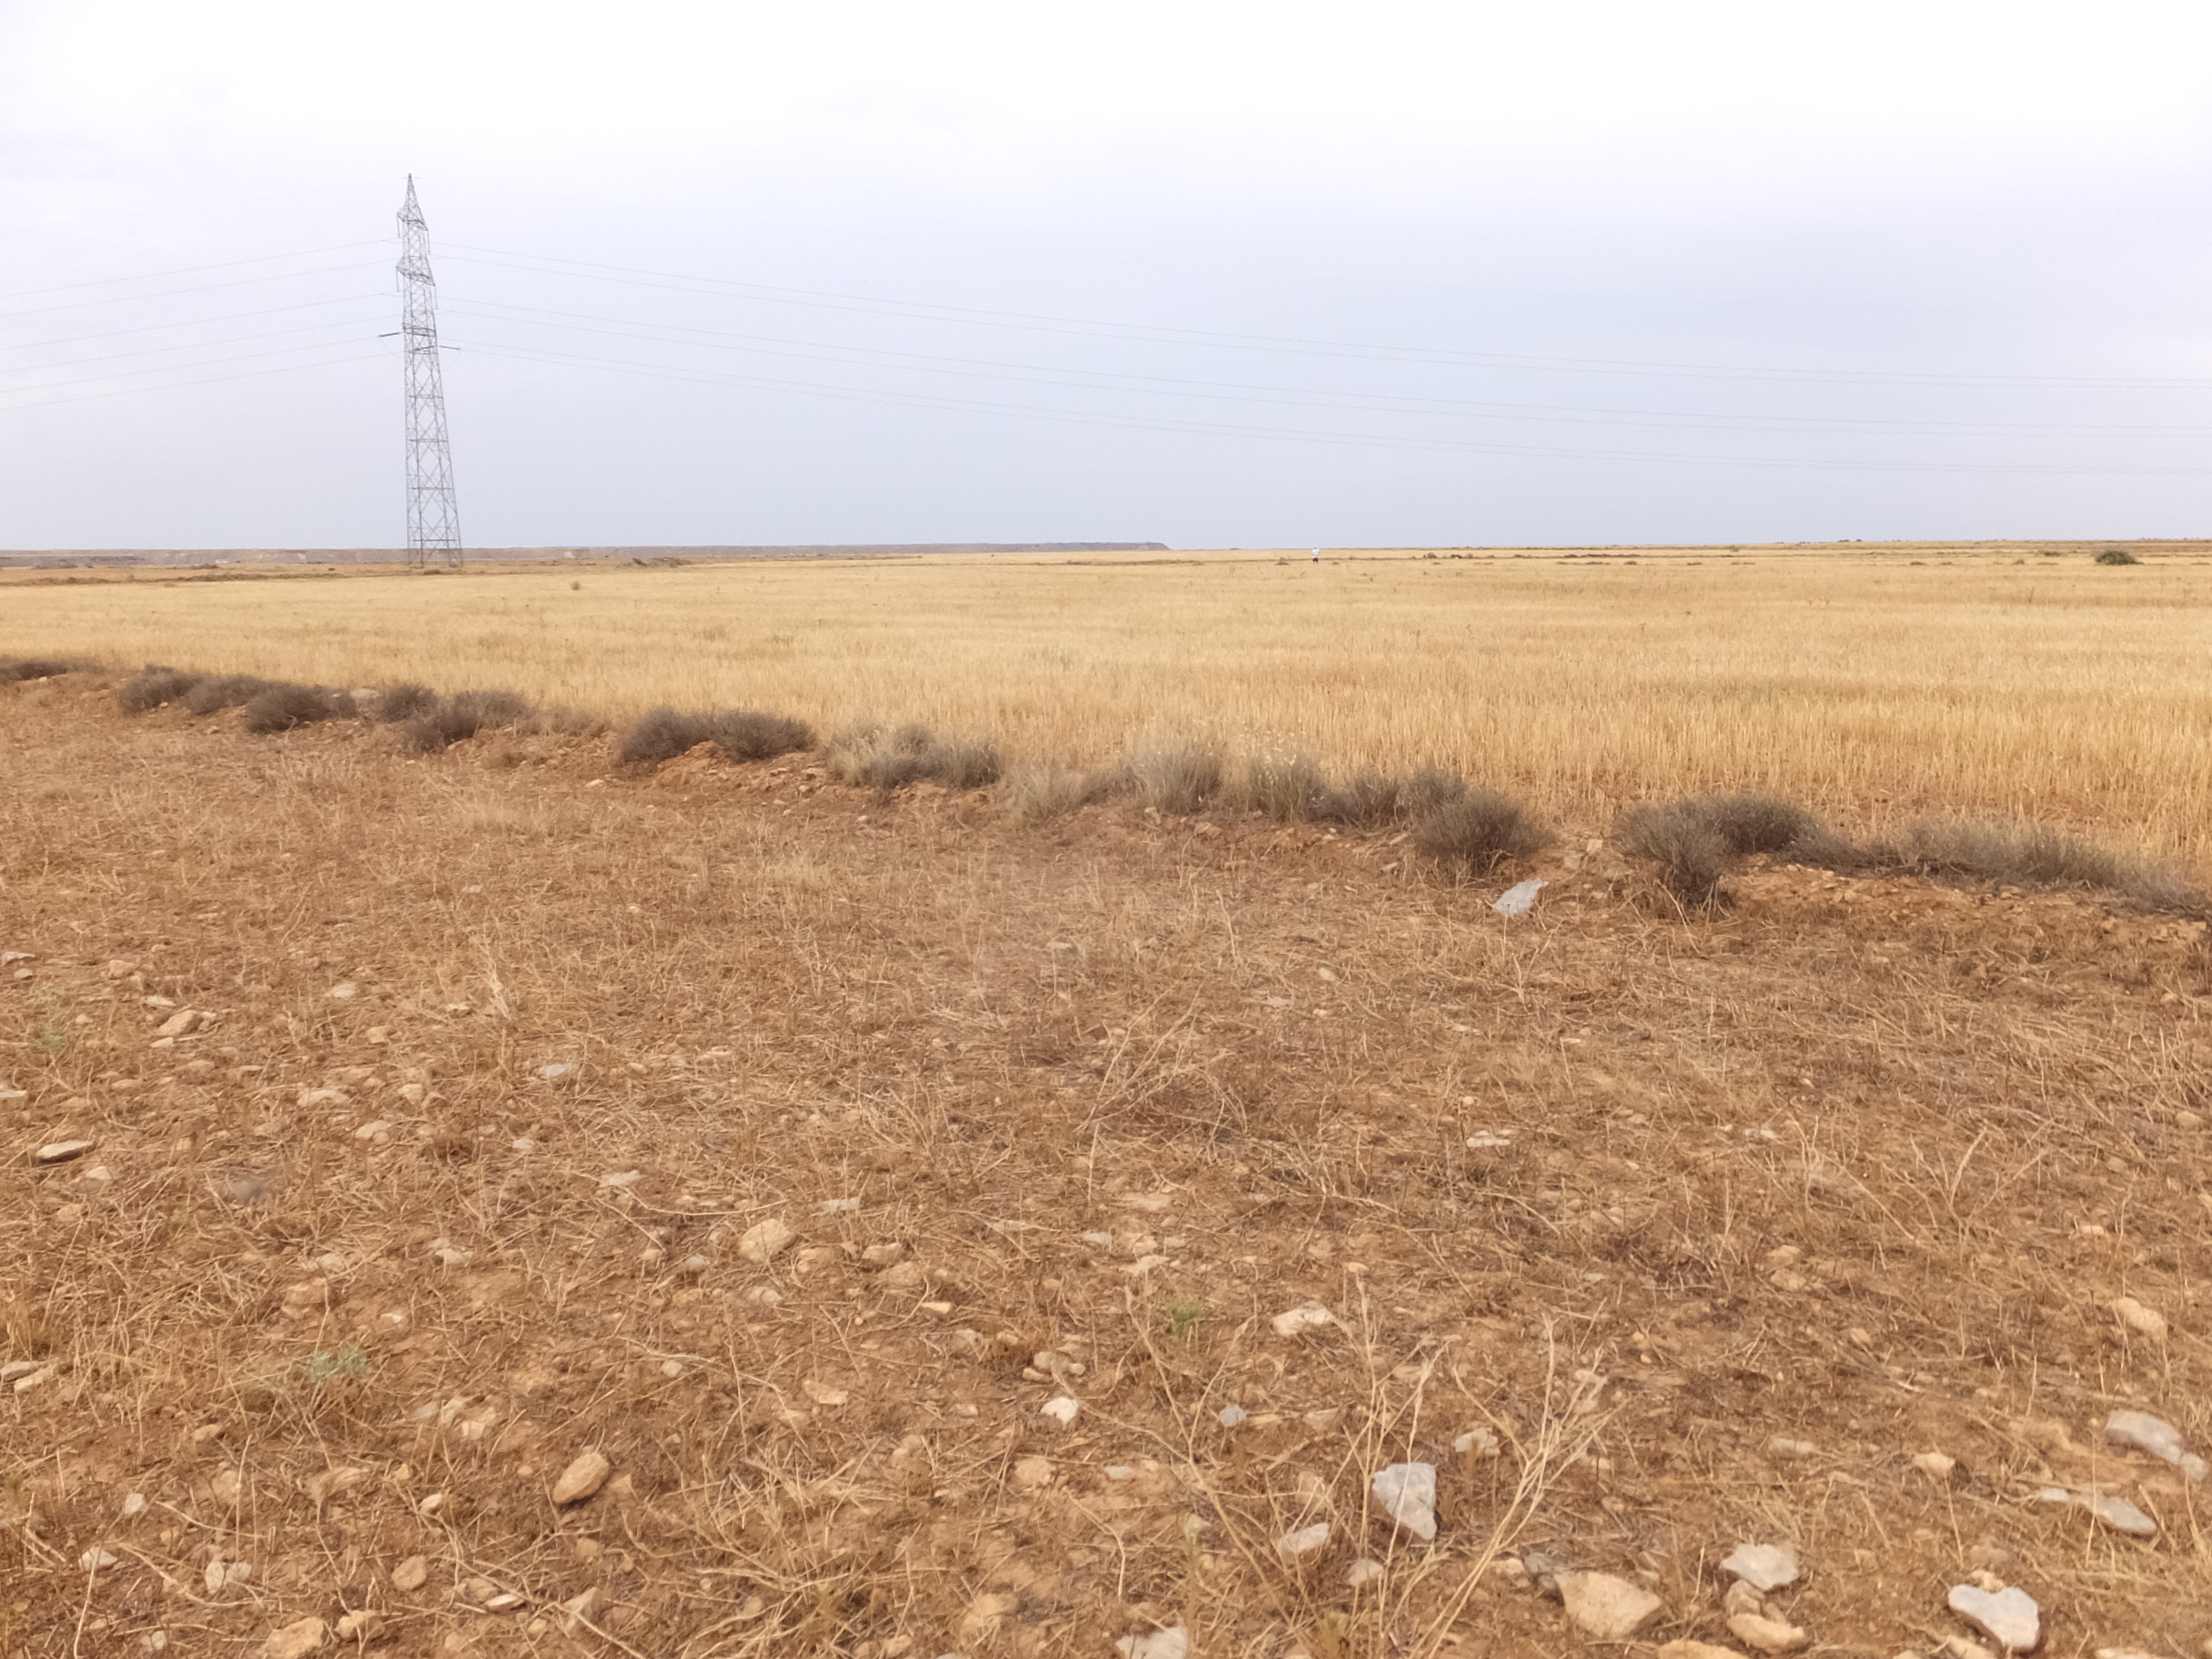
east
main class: Grassland
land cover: Grassland without tree/shrub cover
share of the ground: 25 - 50 %
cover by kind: unconsolidated bare surface 50 %, herbaceous plants 45 %, shrubs 5 %
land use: Agriculture (excluding fallow land and kitchen gardens)
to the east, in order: Grassland without tree/shrub cover; Grass margins; Barley; Grass margins; Barley; Grass margins; Barley; Electric lines; Barley
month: June
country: ES
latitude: 41.6946
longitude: 0.0956
